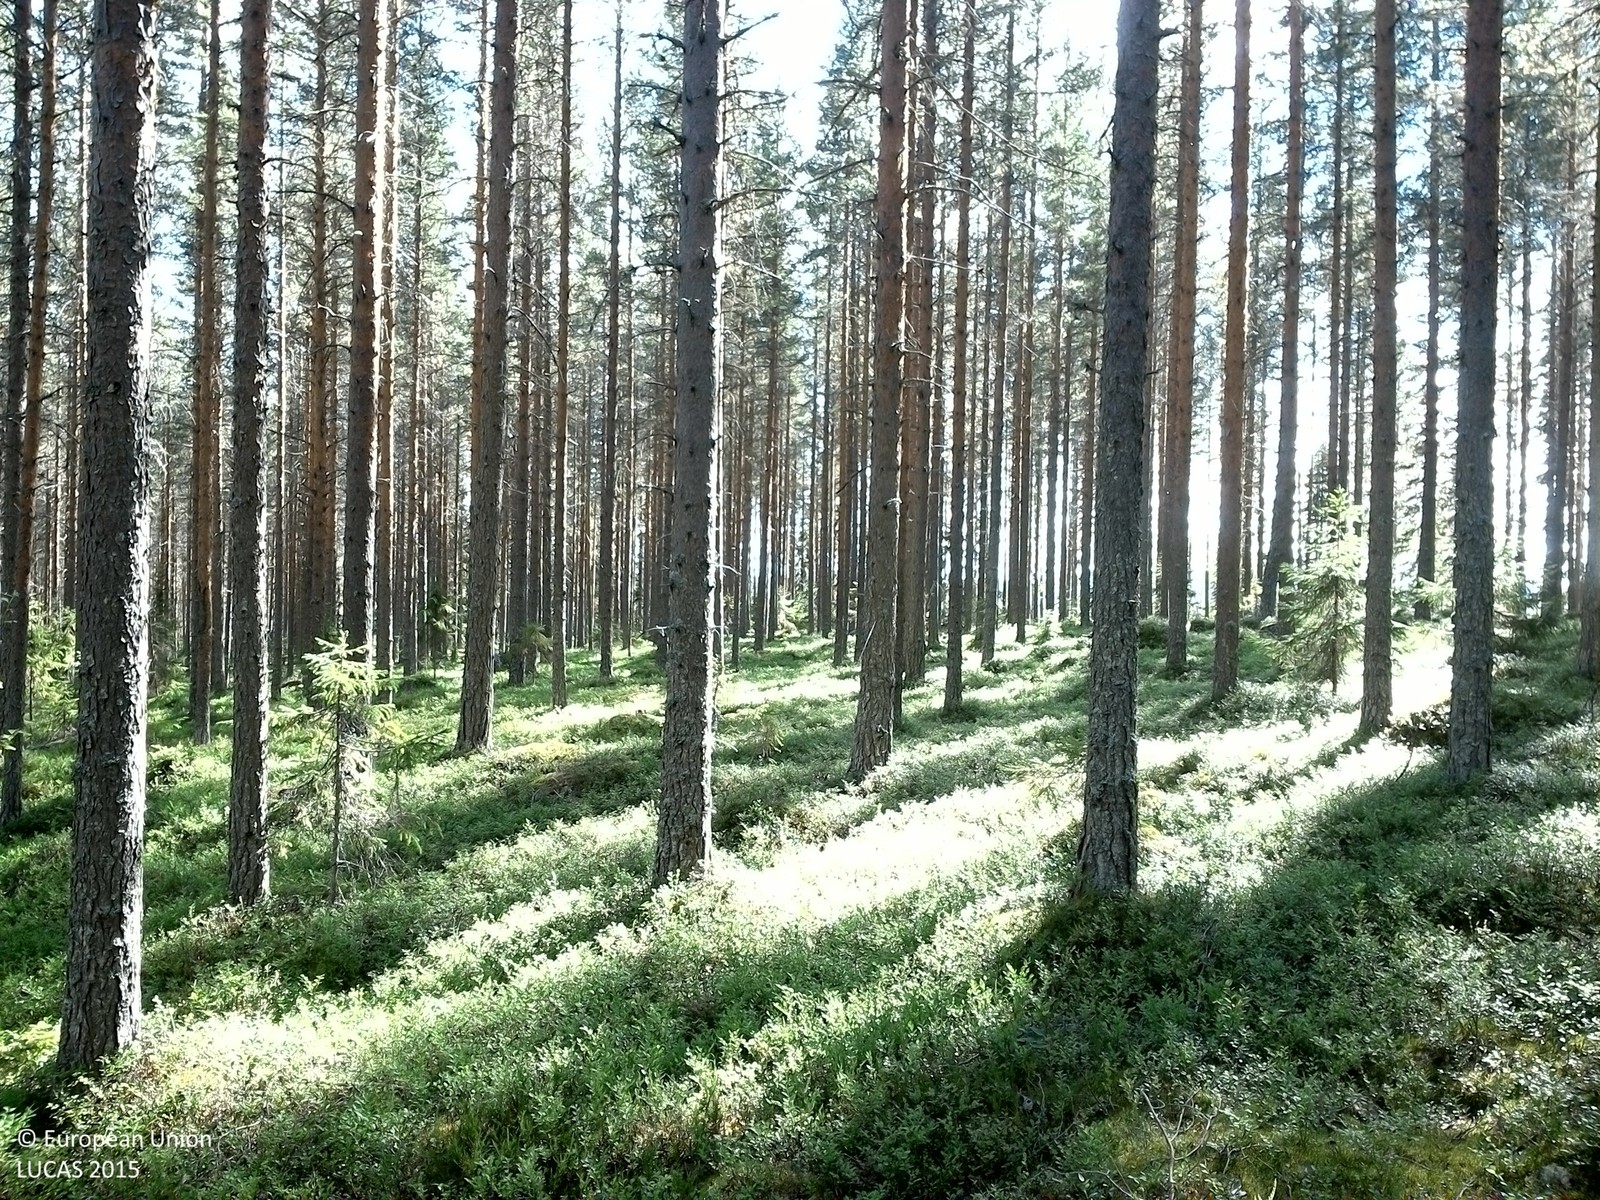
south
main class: Woodland
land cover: Pine dominated coniferous woodland
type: boreal forest
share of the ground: 50 - 75 %
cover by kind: coniferous forest trees 65 %, shrubs 30 %, herbaceous plants 5 %
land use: Forestry
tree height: > 5 m
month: August
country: SE
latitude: 63.5962
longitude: 18.0162
